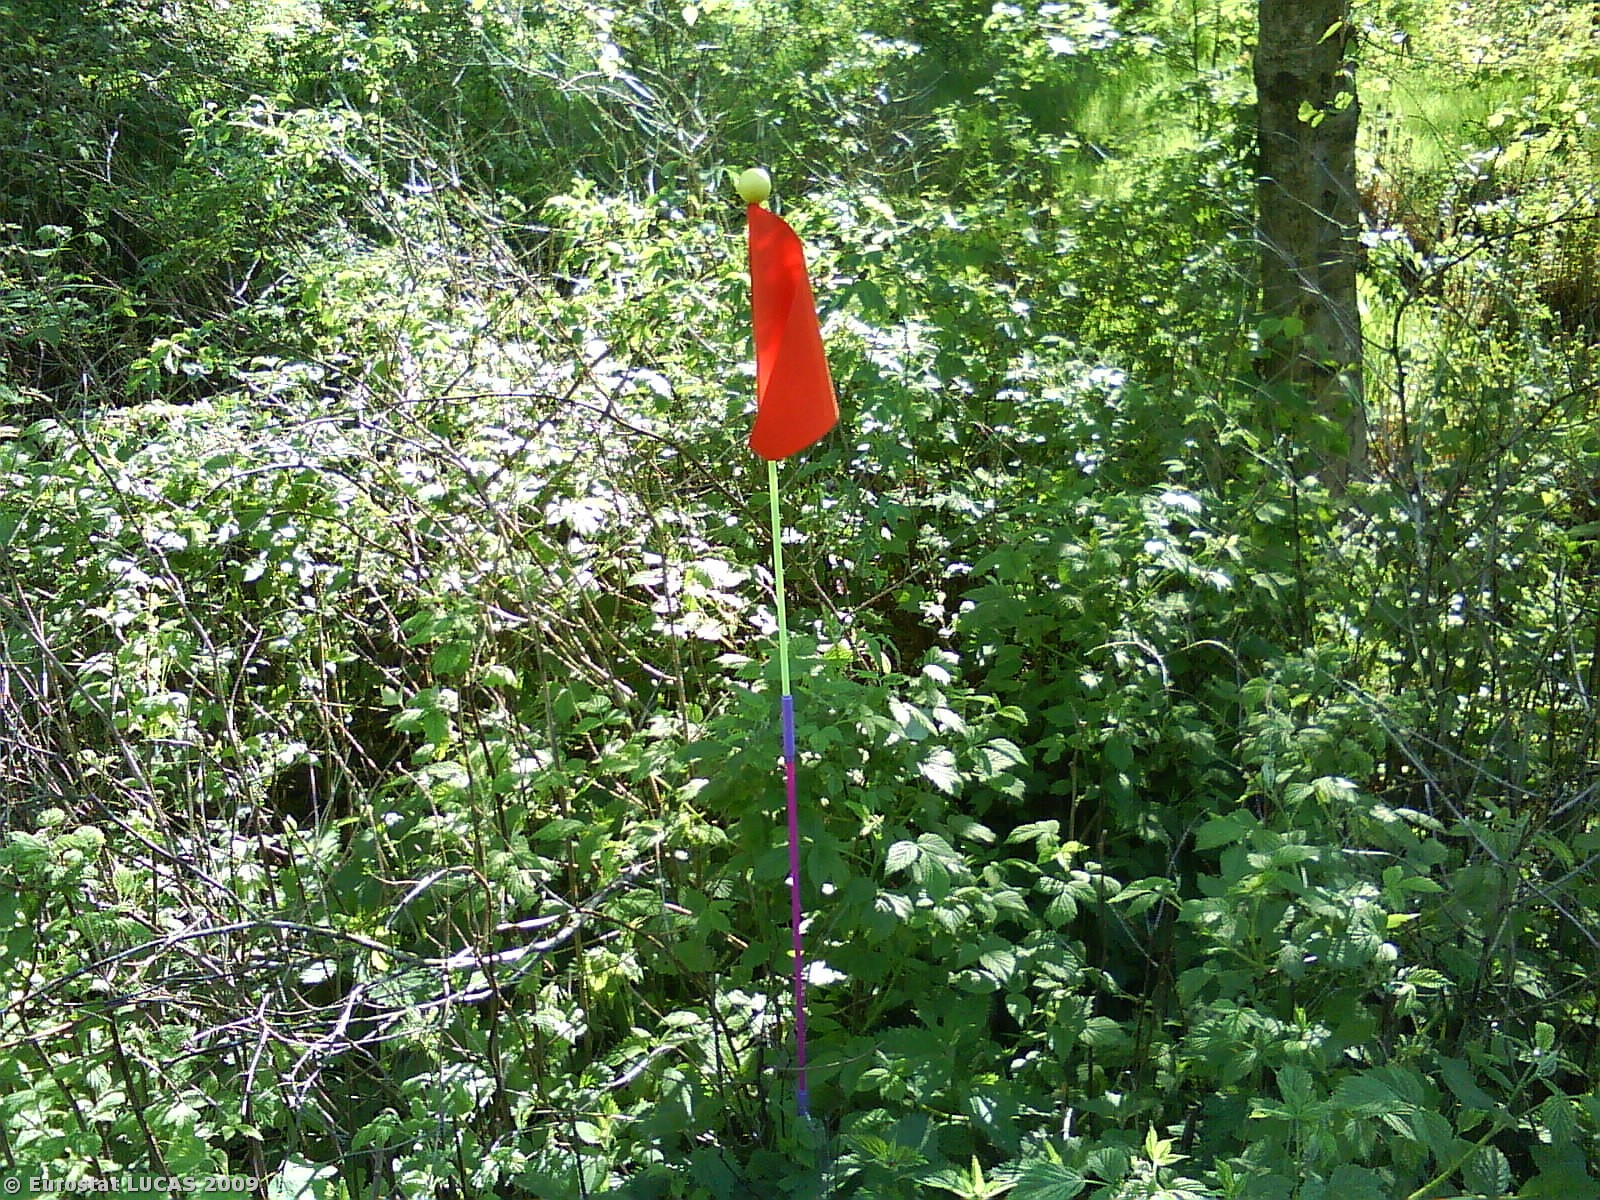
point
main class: Woodland
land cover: Broadleaved woodland
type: plantations and self-sown exotic forest
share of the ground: 25 - 50 %
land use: Forestry
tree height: > 5 m
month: May
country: DK
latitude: 56.4549
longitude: 10.7941
